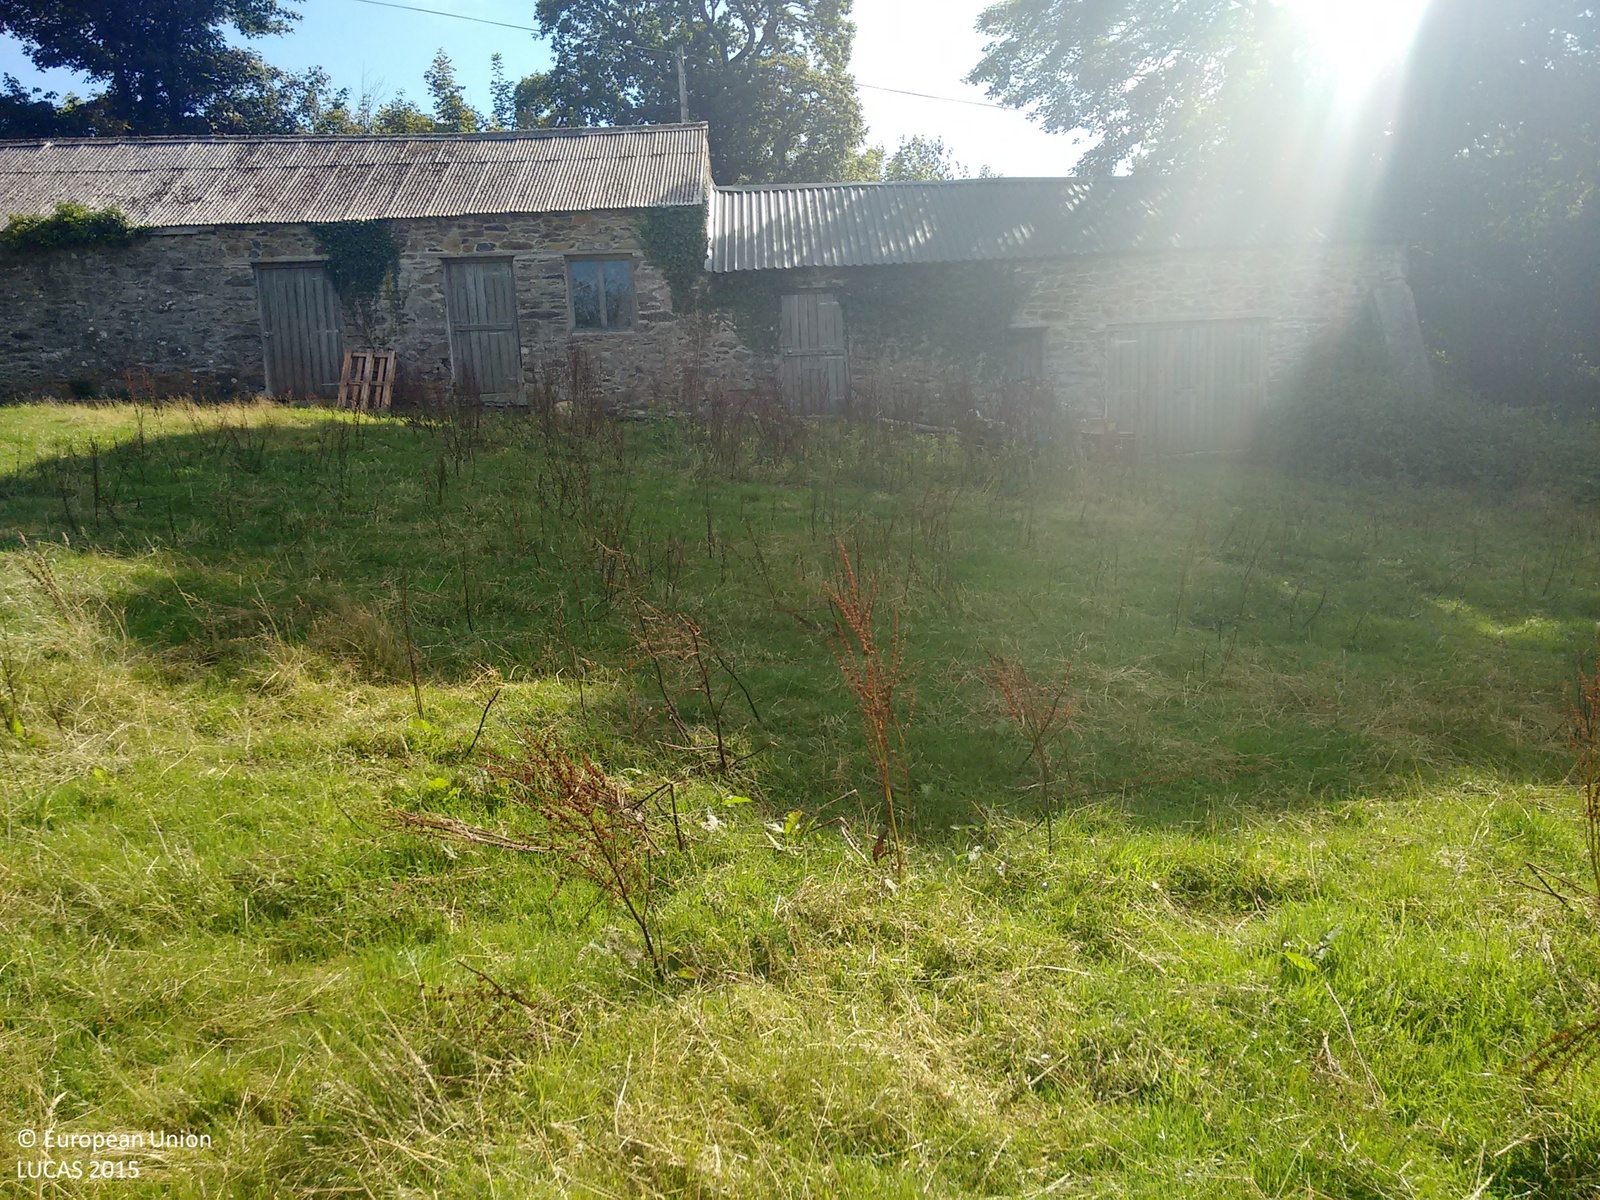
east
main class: Grassland
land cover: Grassland without tree/shrub cover
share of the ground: > 75 %
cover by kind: herbaceous plants 100 %
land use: Agriculture (excluding fallow land and kitchen gardens)
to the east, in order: Grassland without tree/shrub cover; Artificial constructions in urban areas; Shruby margins; Paved roads, cycling and walking lanes; Broadleaved woodland; Fences; Grassland without tree/shrub cover; Electric lines; Grassland without tree/shrub cover; Fences; Managed hedges; Dry stone walls; Fences; Grassland without tree/shrub cover
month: August
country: GB
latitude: 50.2961
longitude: -4.8949
